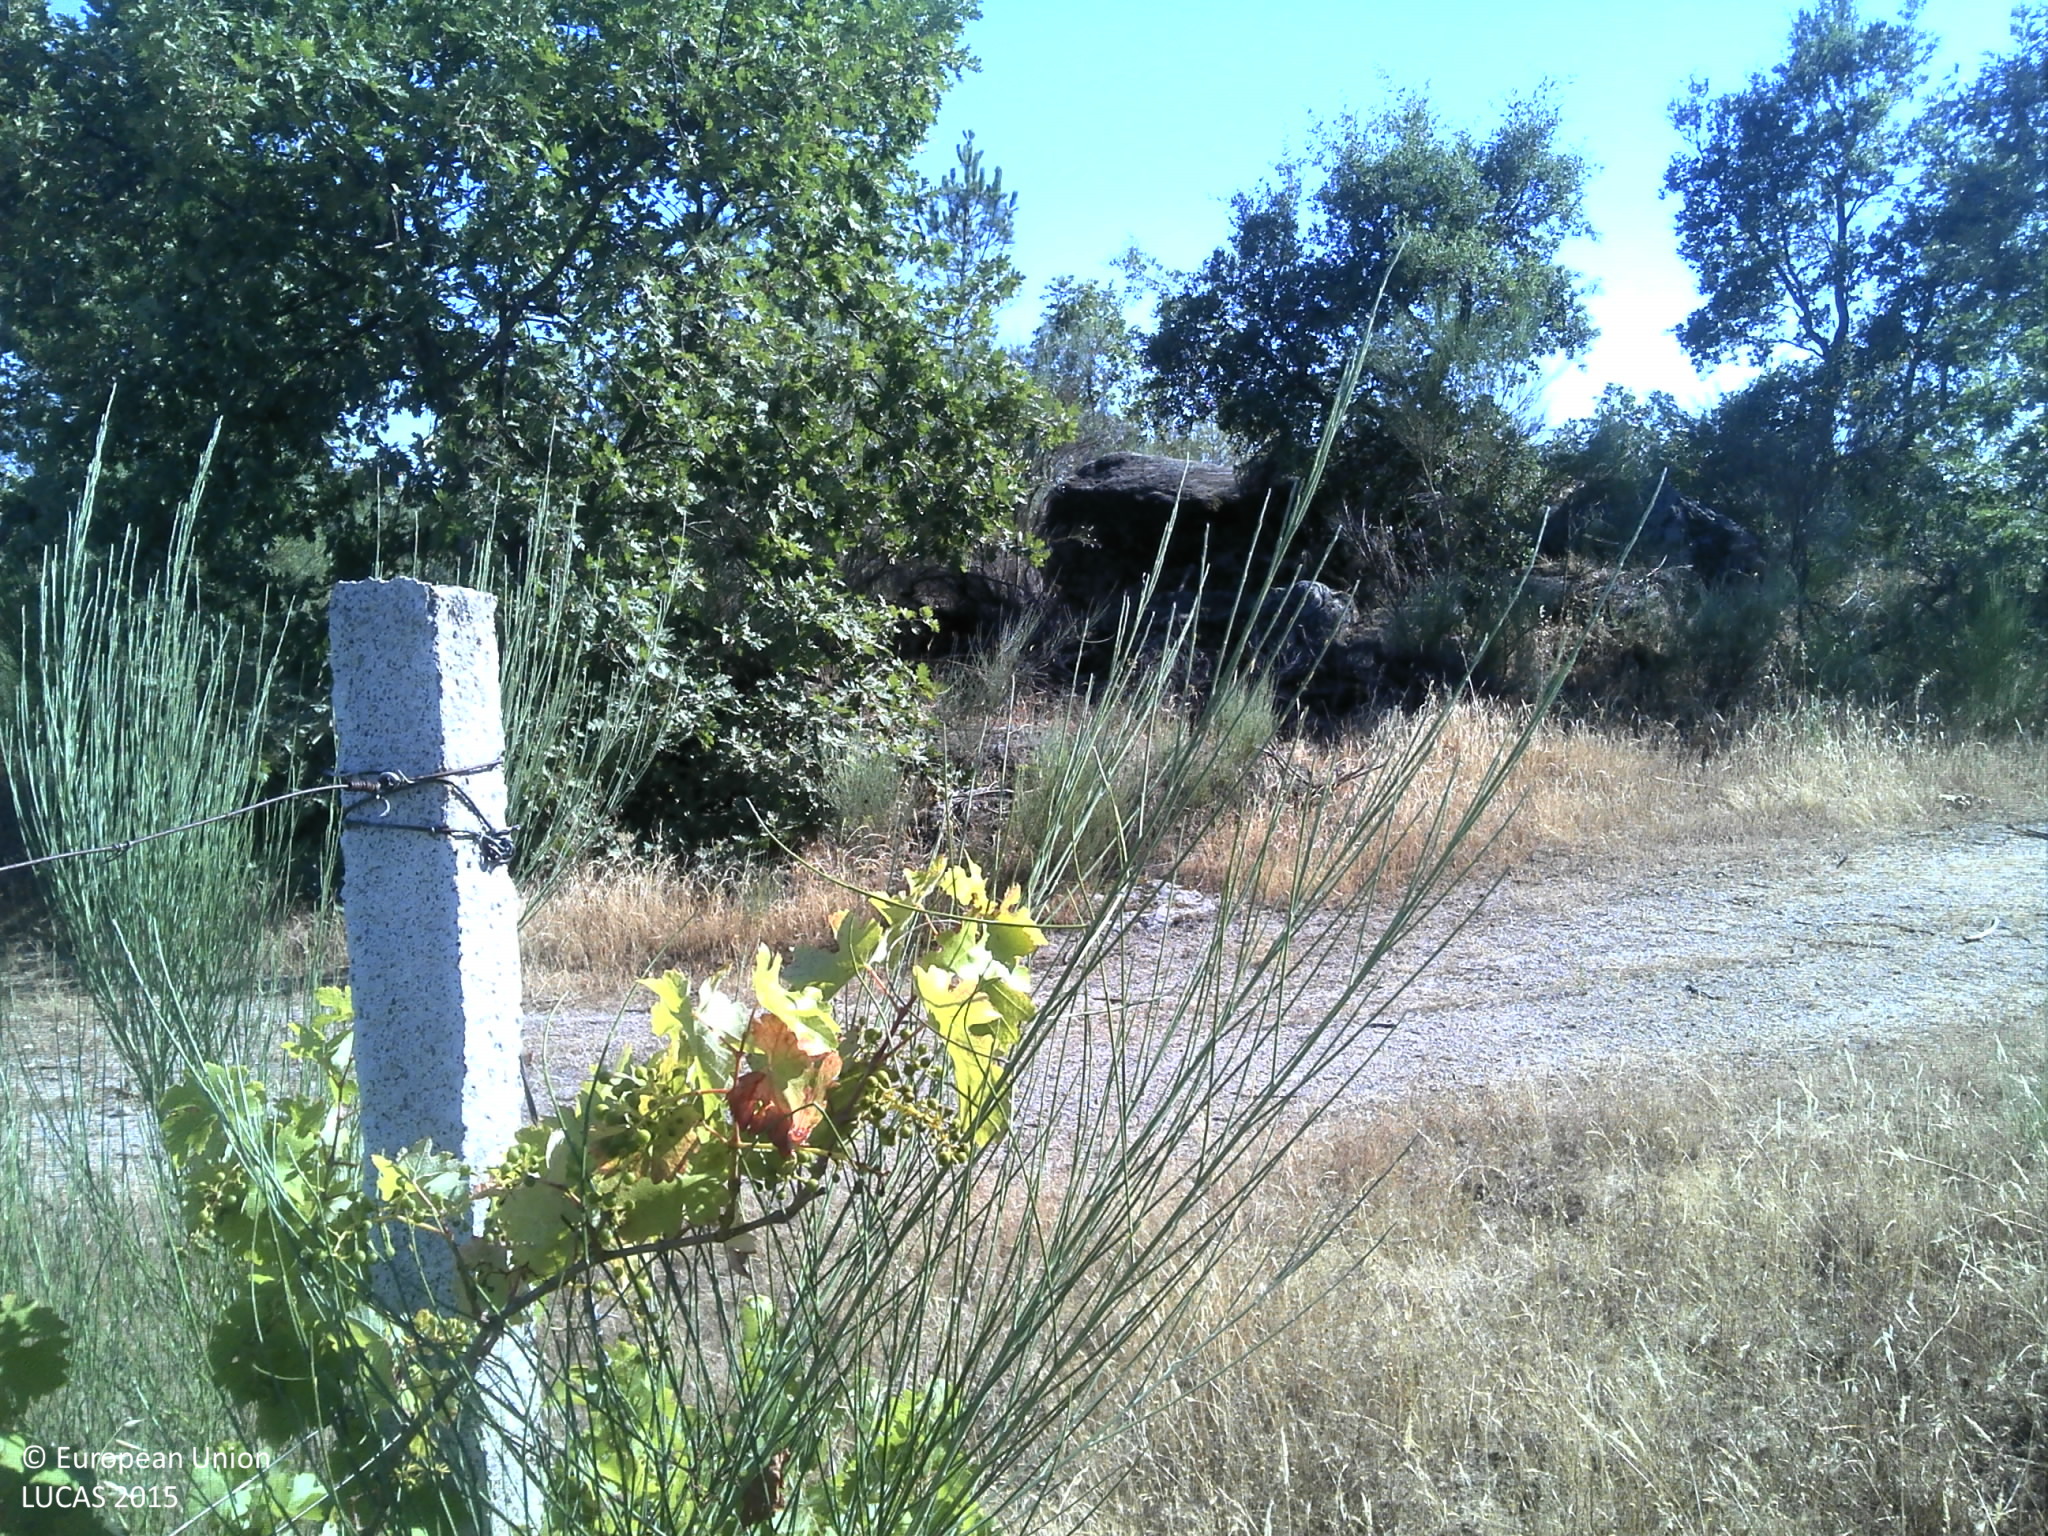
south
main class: Cropland
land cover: Vineyards
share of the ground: 25 - 50 %
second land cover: Spontaneously vegetated surfaces
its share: > 75 %
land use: Agriculture (excluding fallow land and kitchen gardens)
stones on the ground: 10 - 25 %
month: June
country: PT
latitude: 40.0398
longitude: -7.4354
